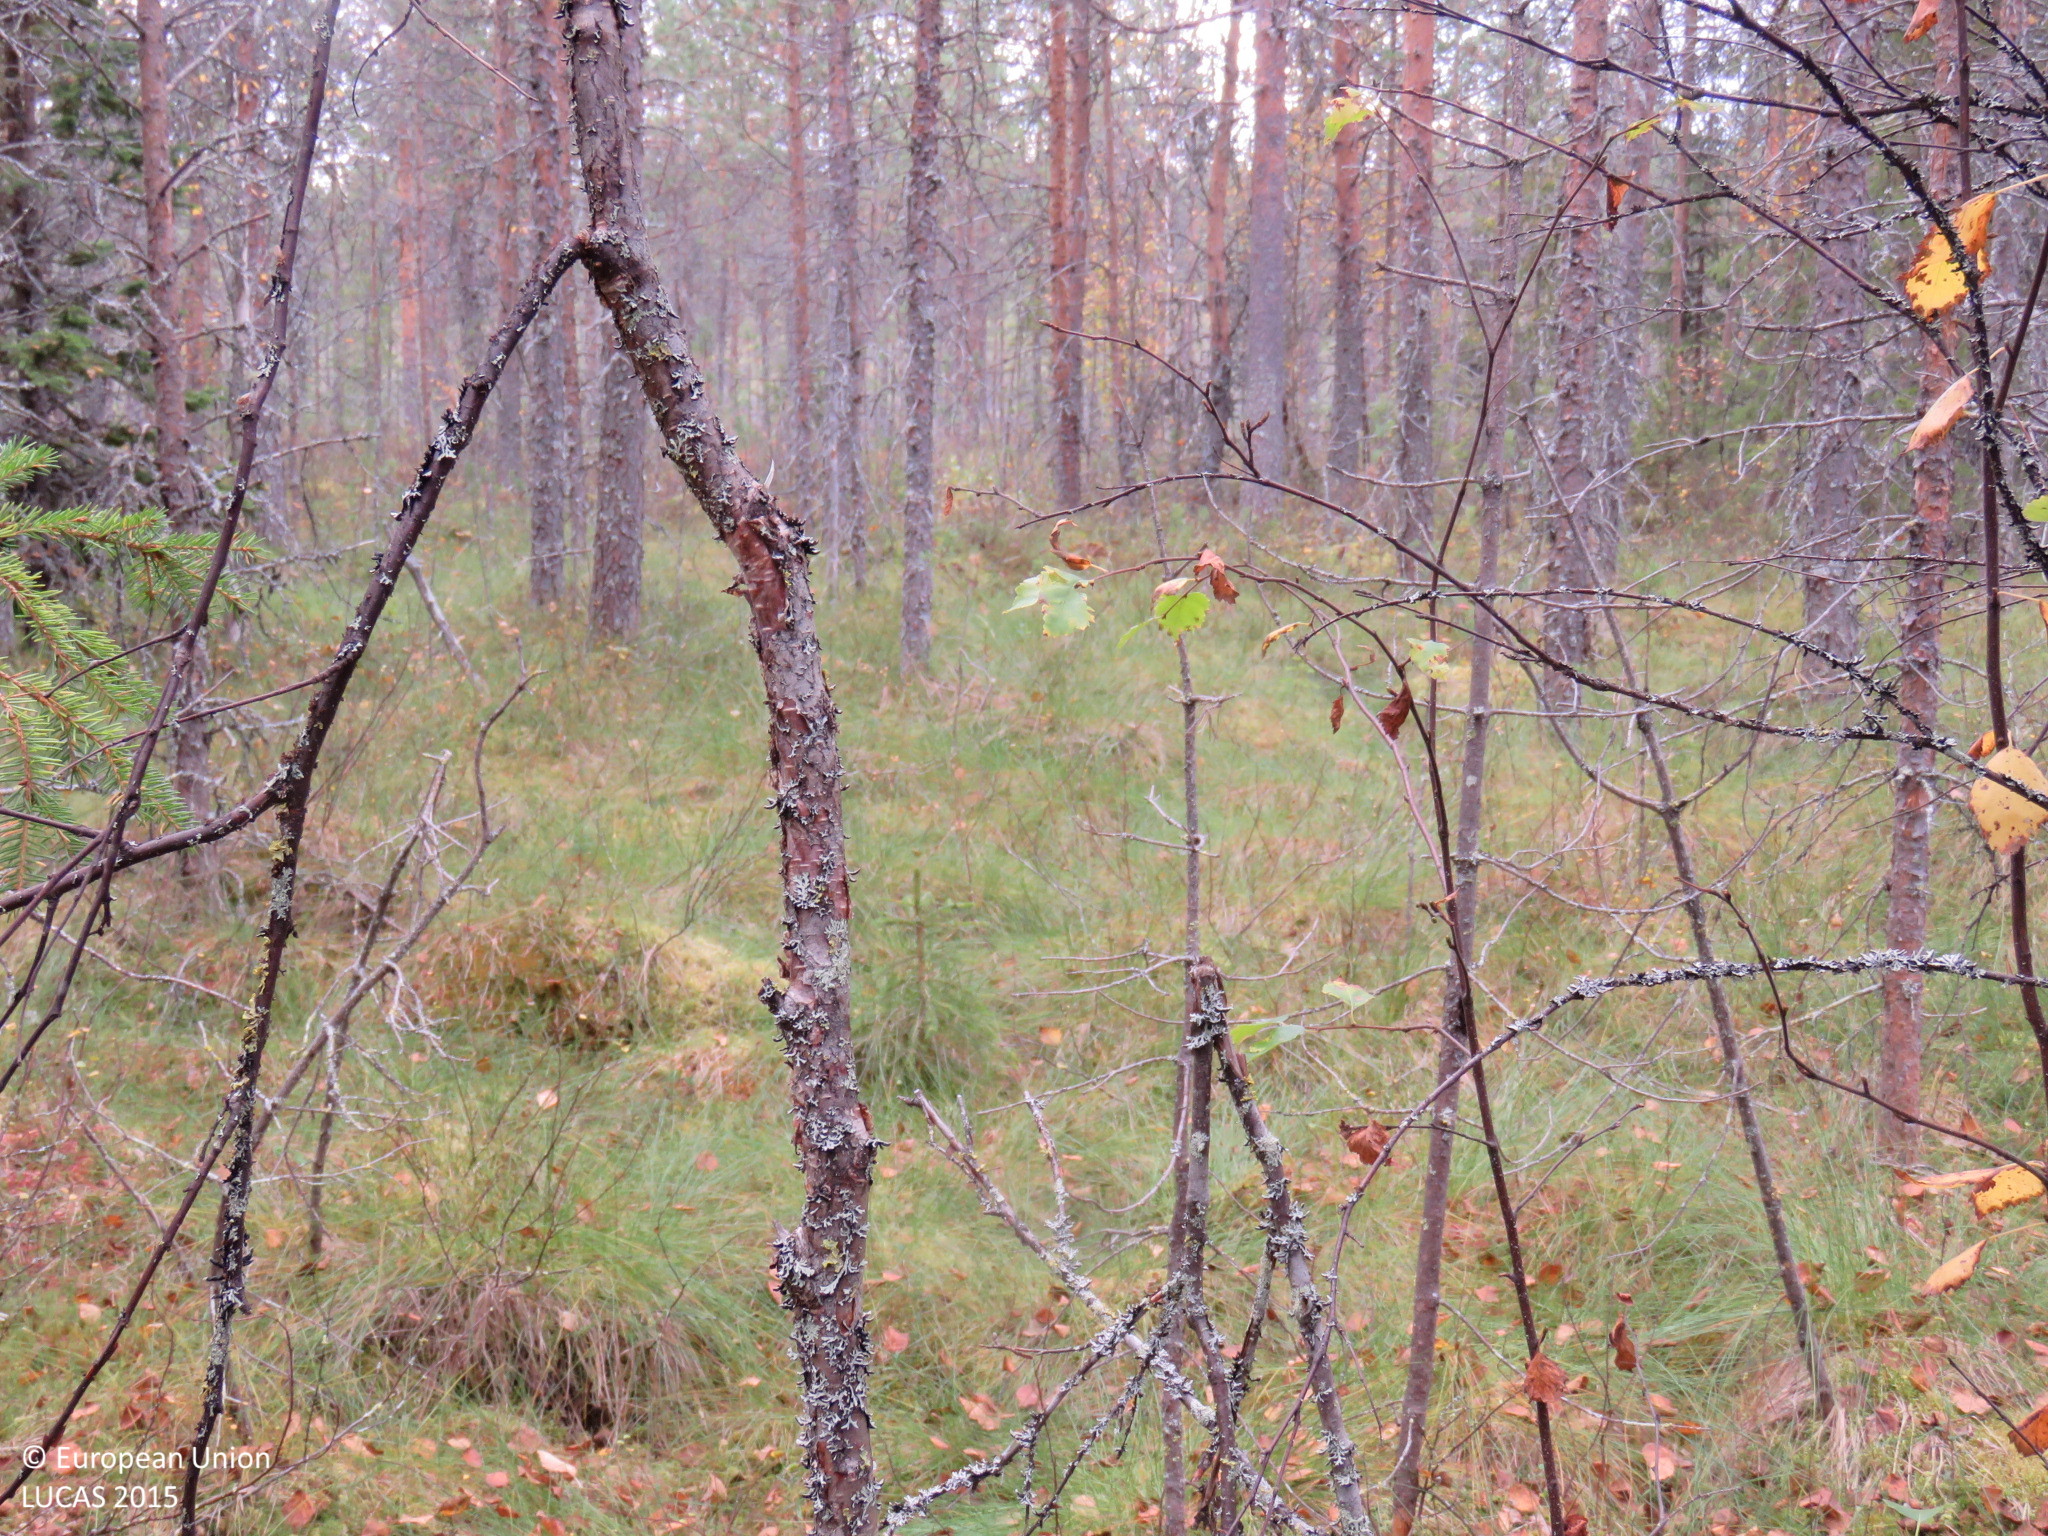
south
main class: Woodland
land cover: Other coniferous woodland
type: mire and swamp forests
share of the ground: > 75 %
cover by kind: coniferous forest trees 60 %, broadleaved forest trees 15 %, shrubs 10 %, herbaceous plants 10 %, lichens and mosses 5 %
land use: Forestry
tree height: > 5 m
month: September
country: FI
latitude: 64.9223
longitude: 26.9748
